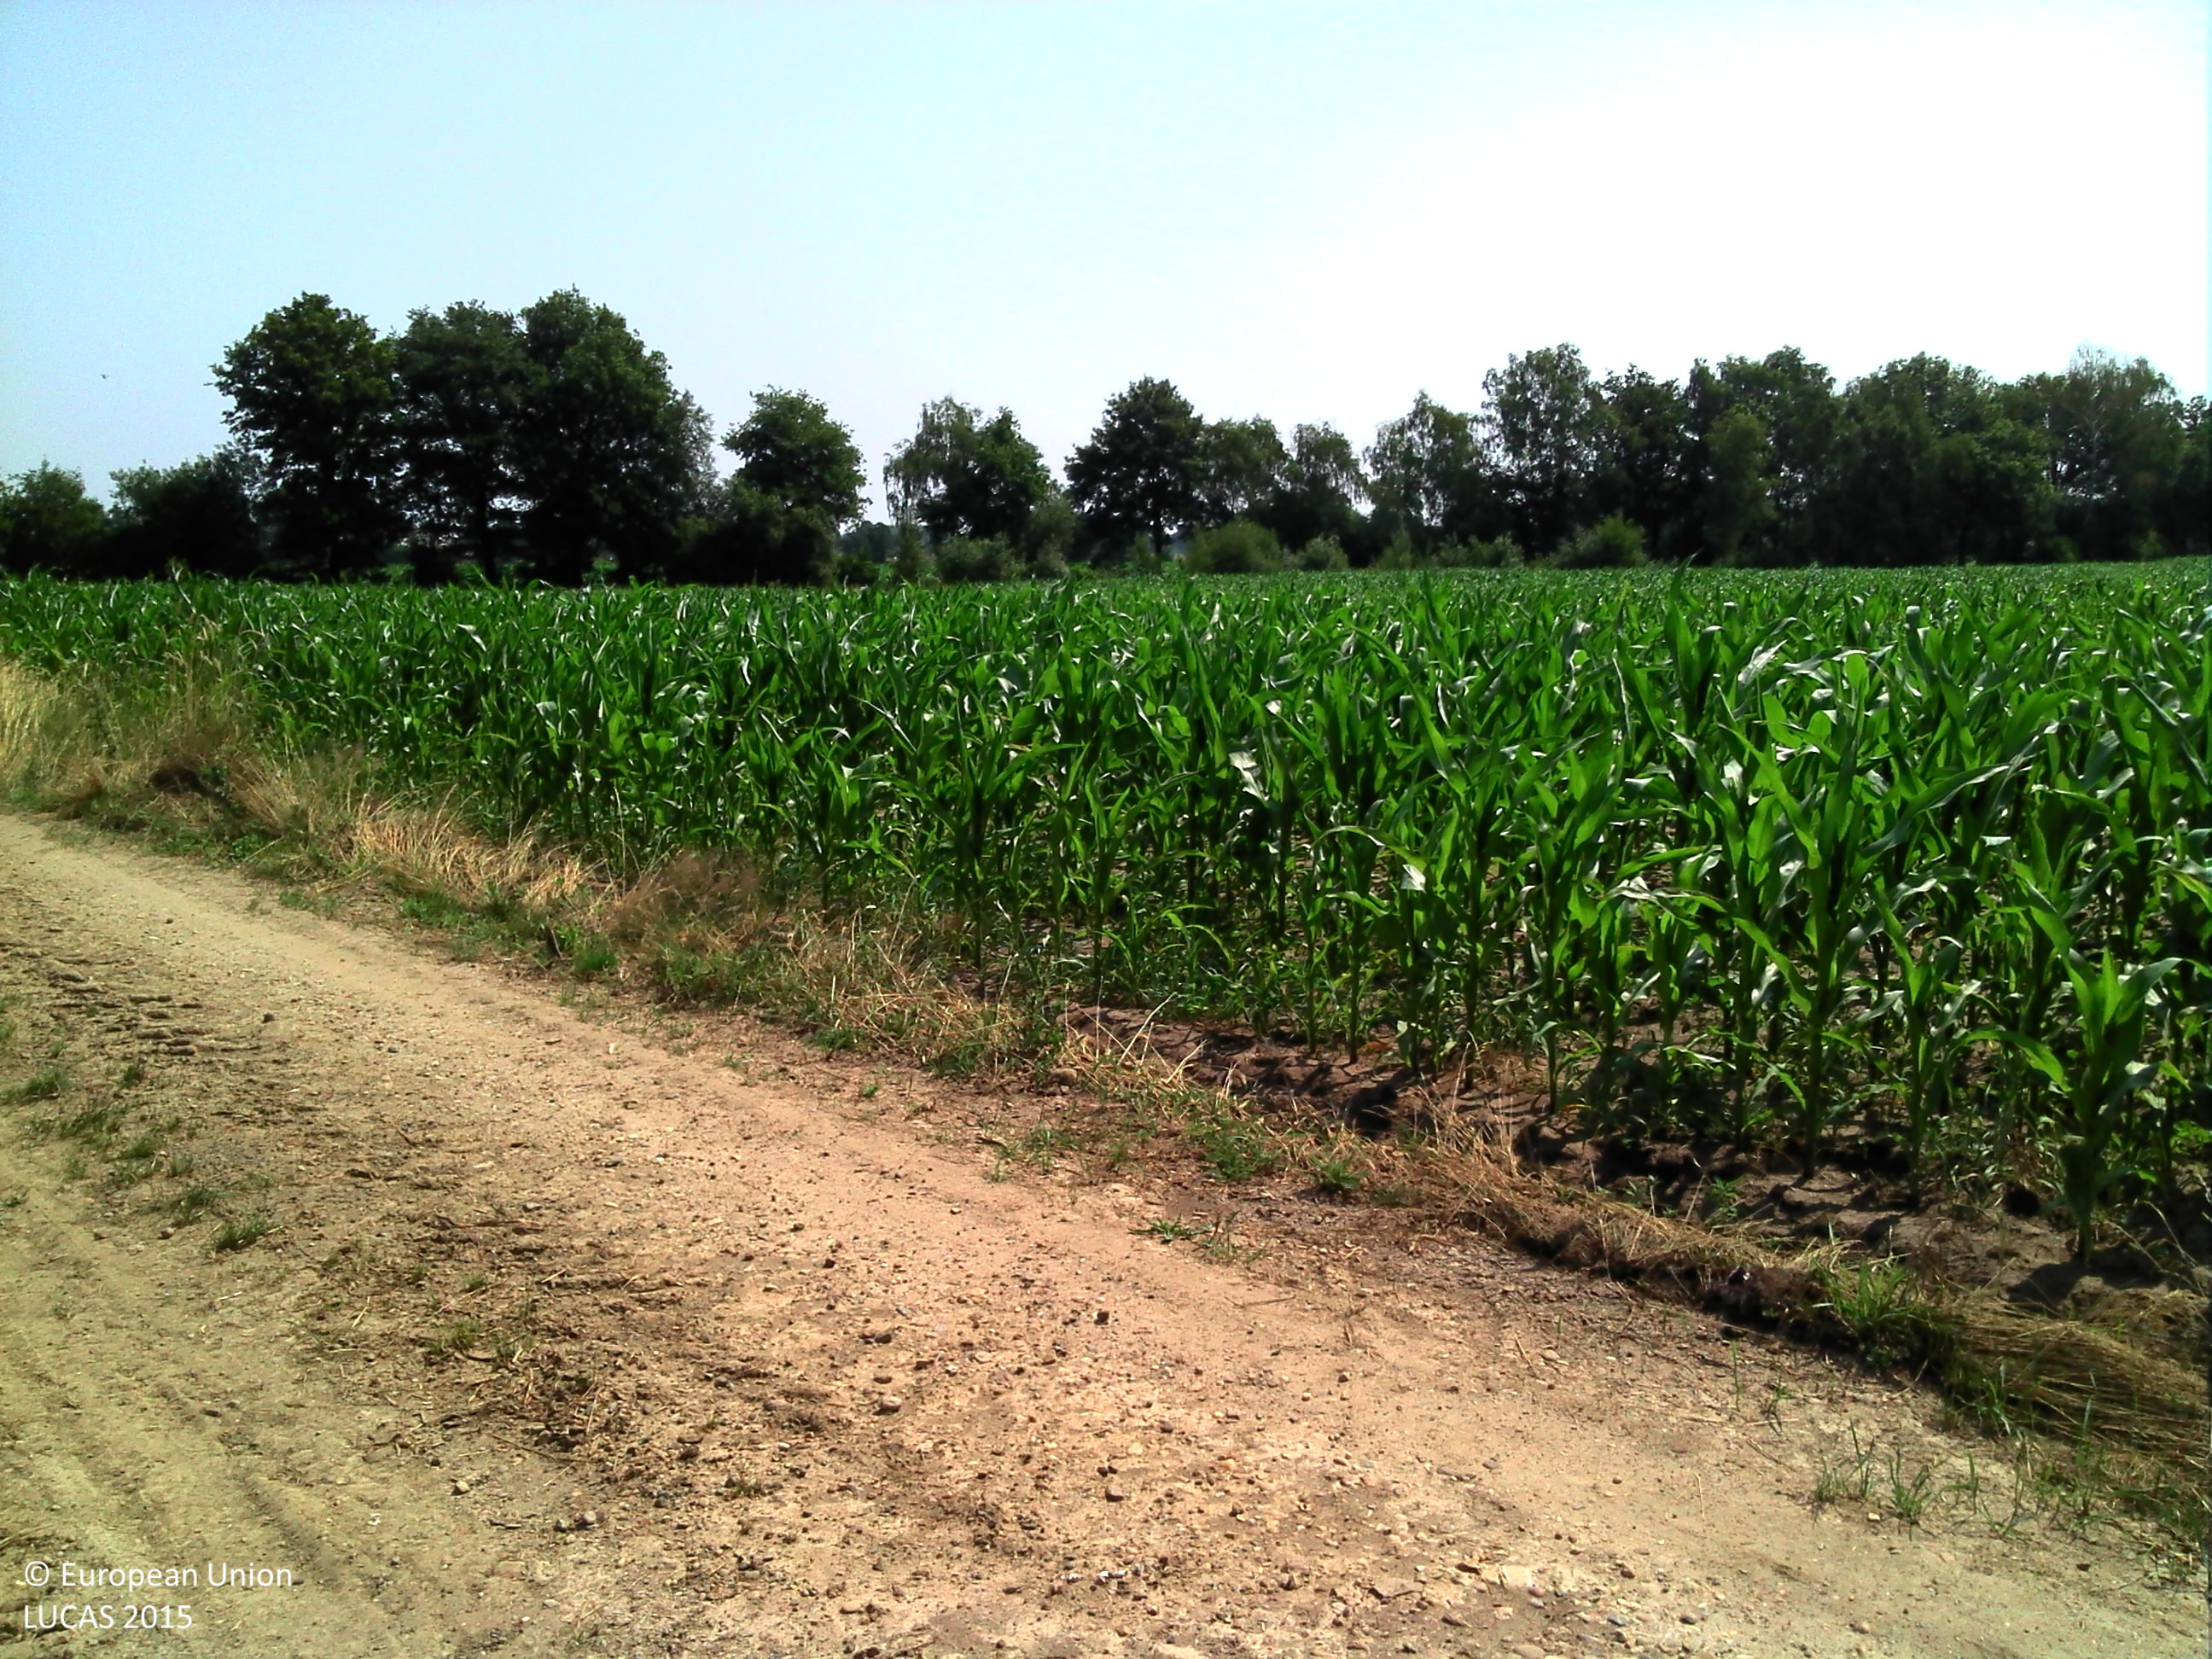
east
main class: Cropland
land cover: Maize
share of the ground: > 75 %
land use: Agriculture (excluding fallow land and kitchen gardens)
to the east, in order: Tracks; Maize; Grass margins; Ditches and canals; Managed hedges; Tracks; Broadleaved woodland; Ditches and canals; Grass margins; Maize; Grass margins; Fences; Grass margins; Maize
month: July
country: BE
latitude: 51.0826
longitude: 5.4157
